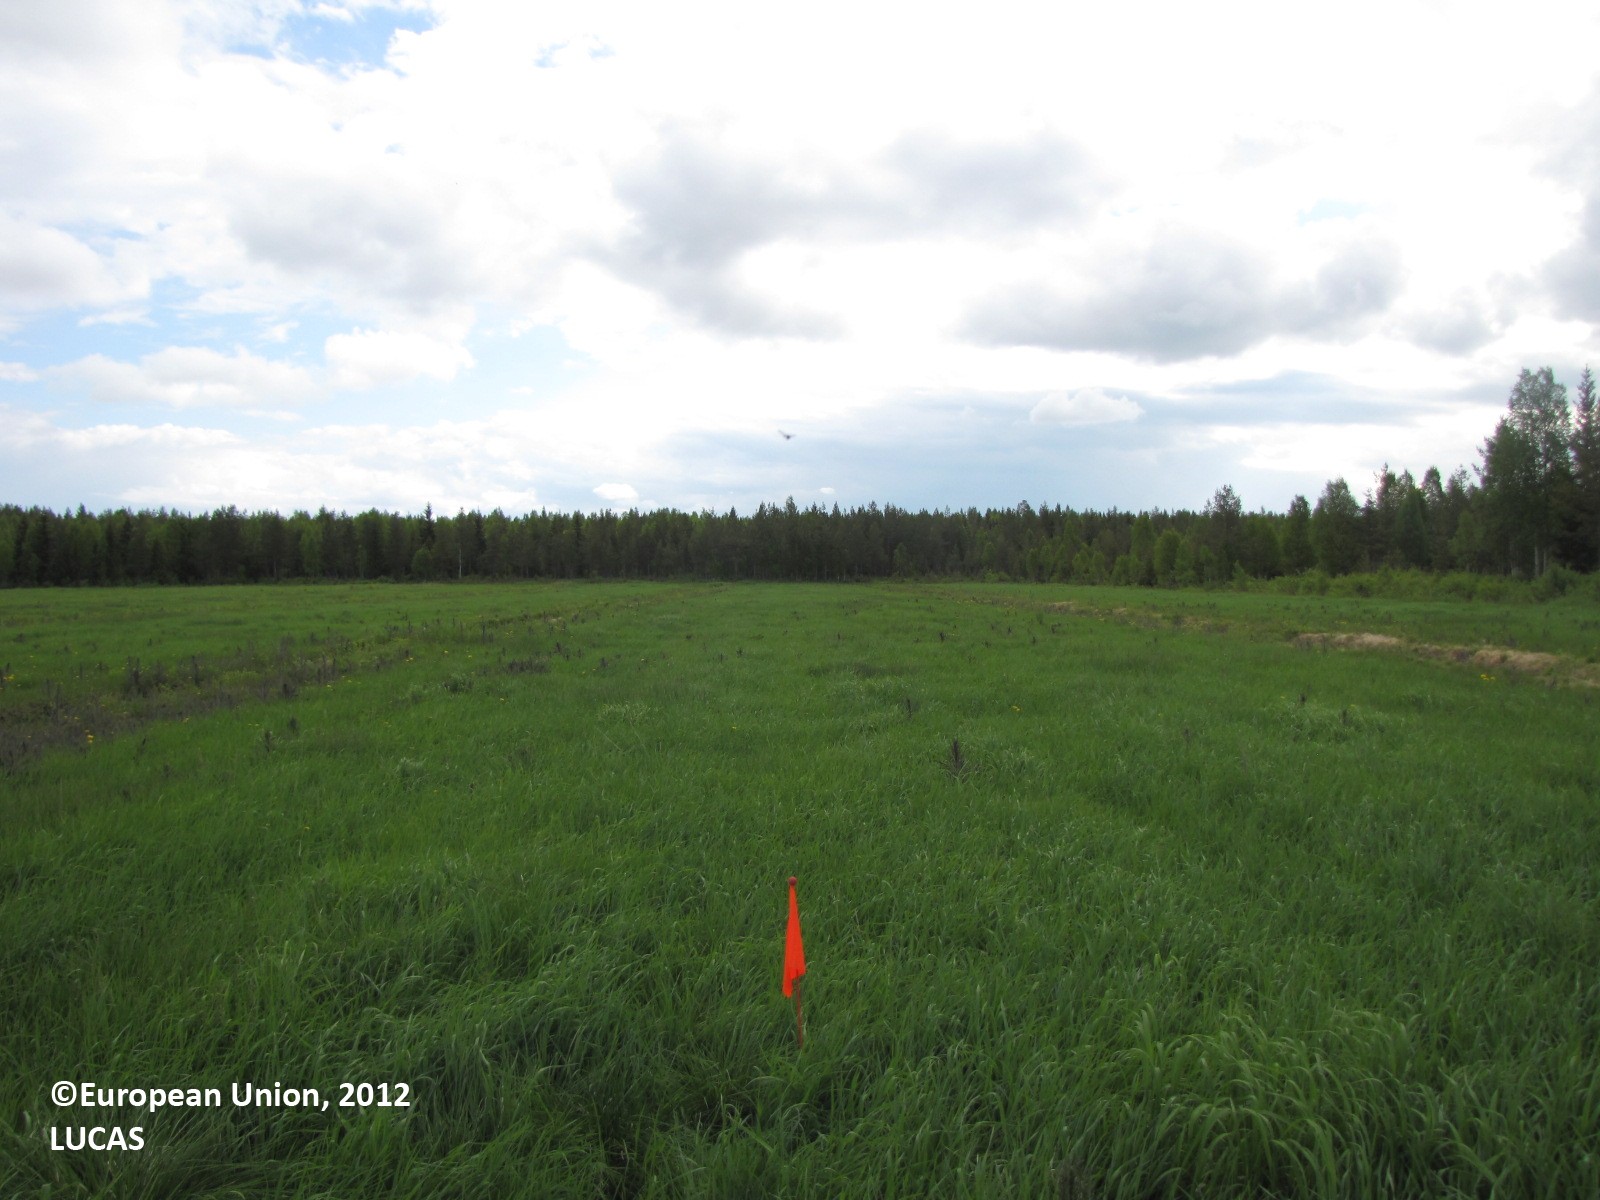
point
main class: Grassland
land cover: Grassland without tree/shrub cover
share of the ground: > 75 %
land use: Agriculture (excluding fallow land and kitchen gardens)
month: June
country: FI
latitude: 66.0910
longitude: 24.2640
